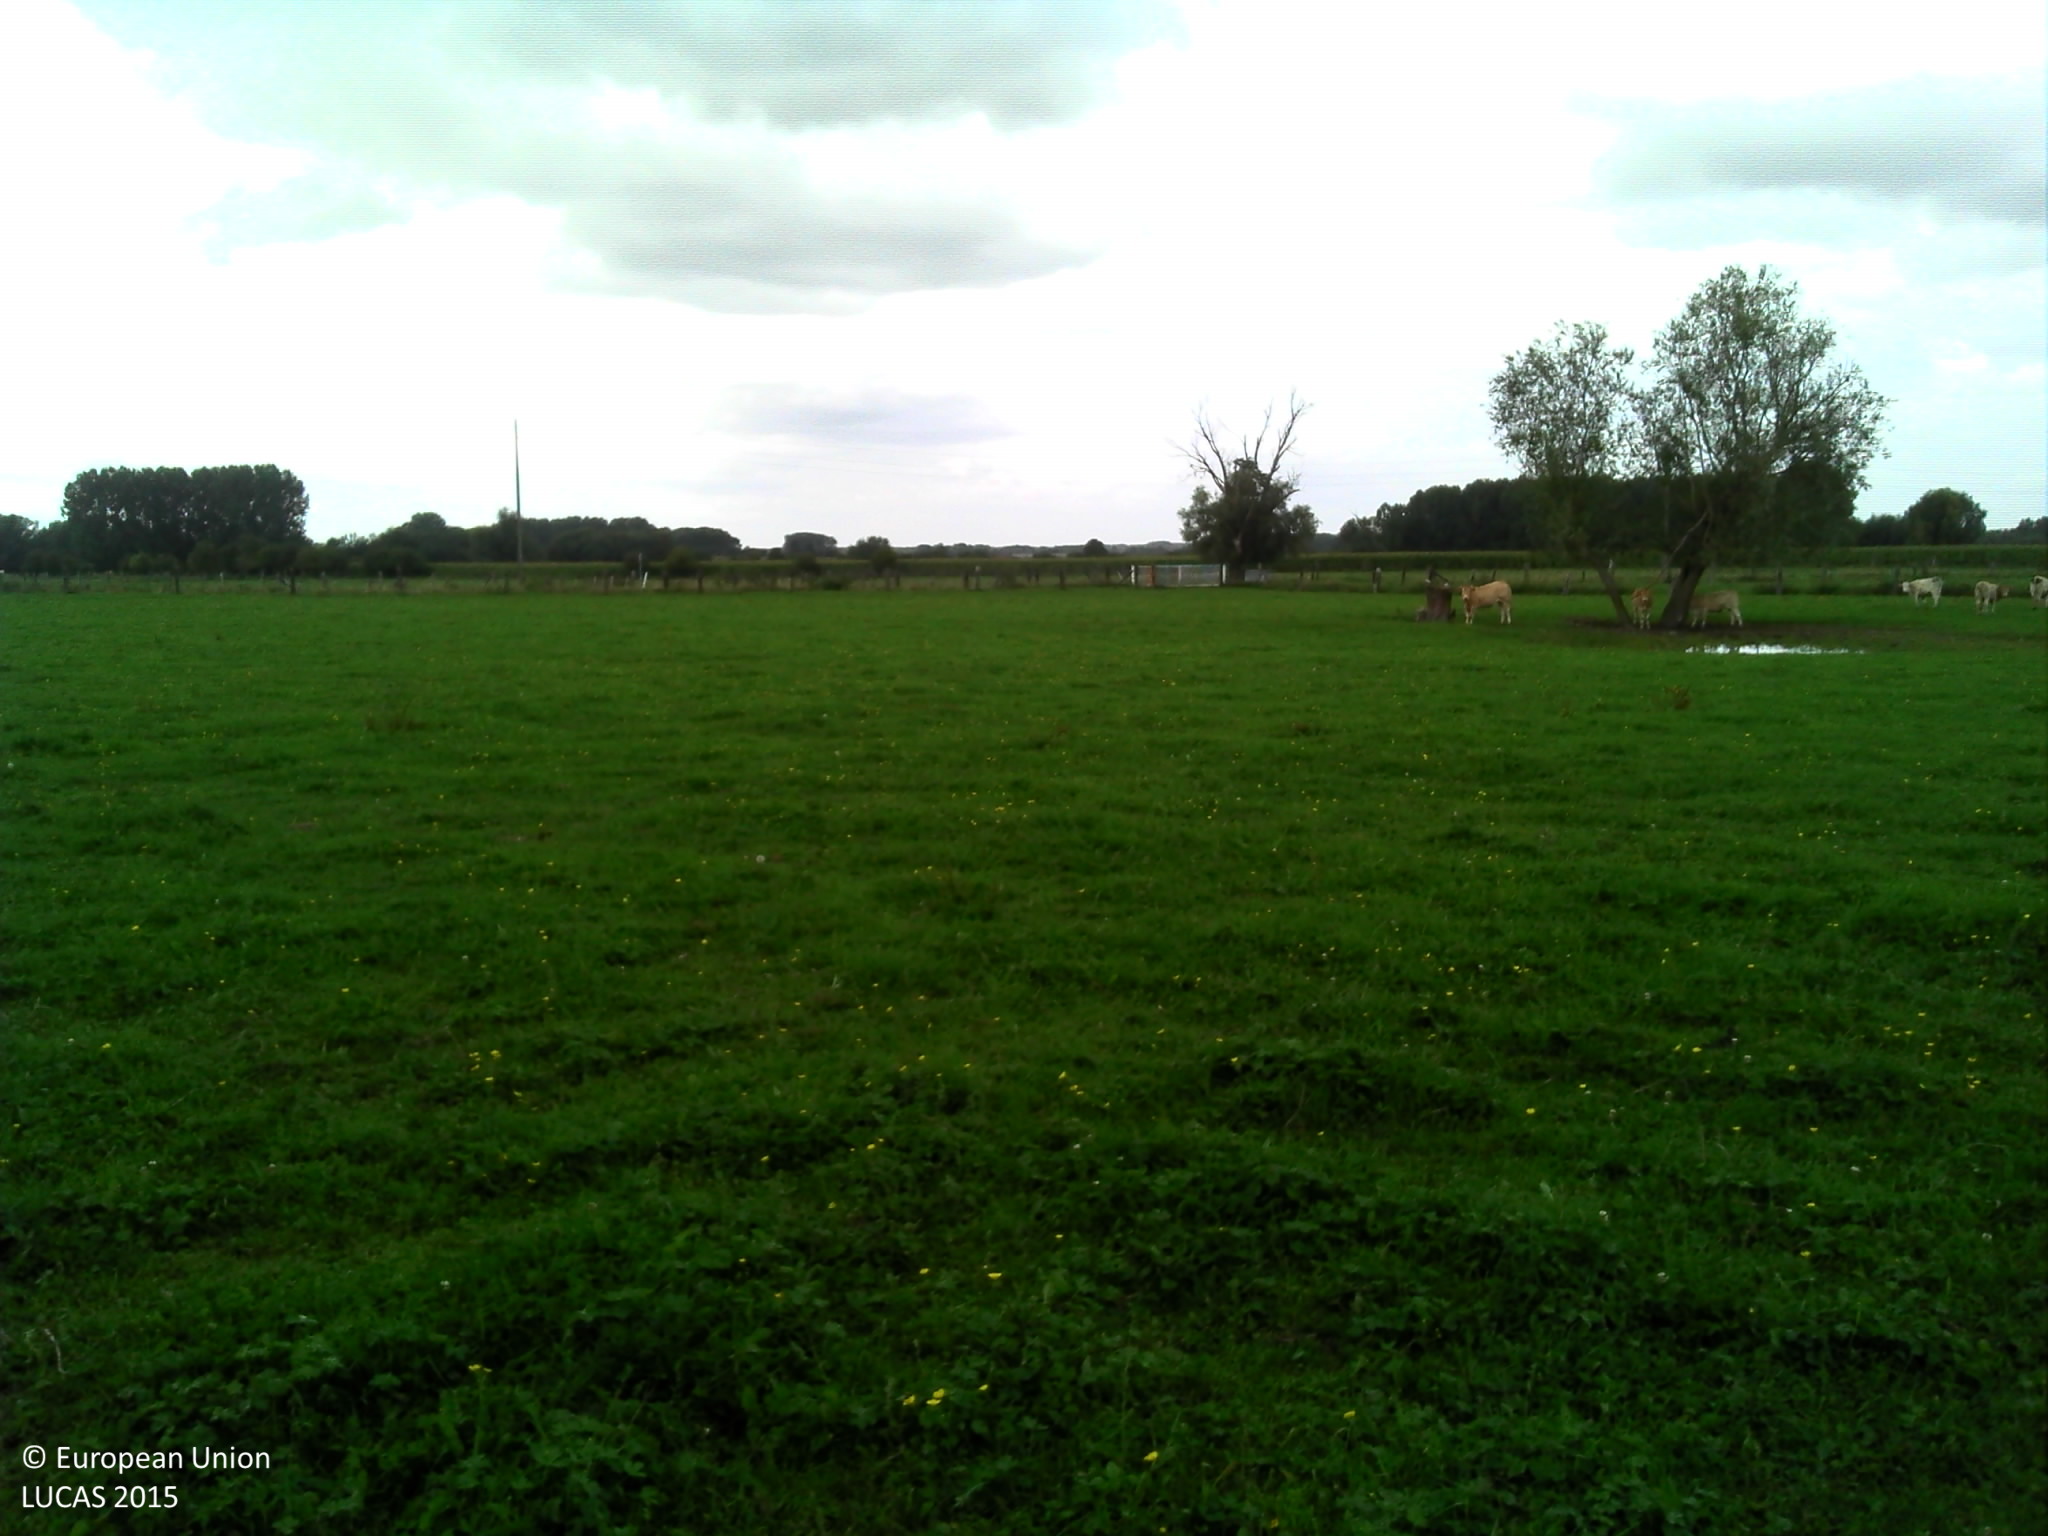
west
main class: Grassland
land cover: Grassland without tree/shrub cover
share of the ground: > 75 %
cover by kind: herbaceous plants 95 %, consolidated bare surface 5 %
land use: Agriculture (excluding fallow land and kitchen gardens)
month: September
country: FR
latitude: 50.4903
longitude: 3.5792
